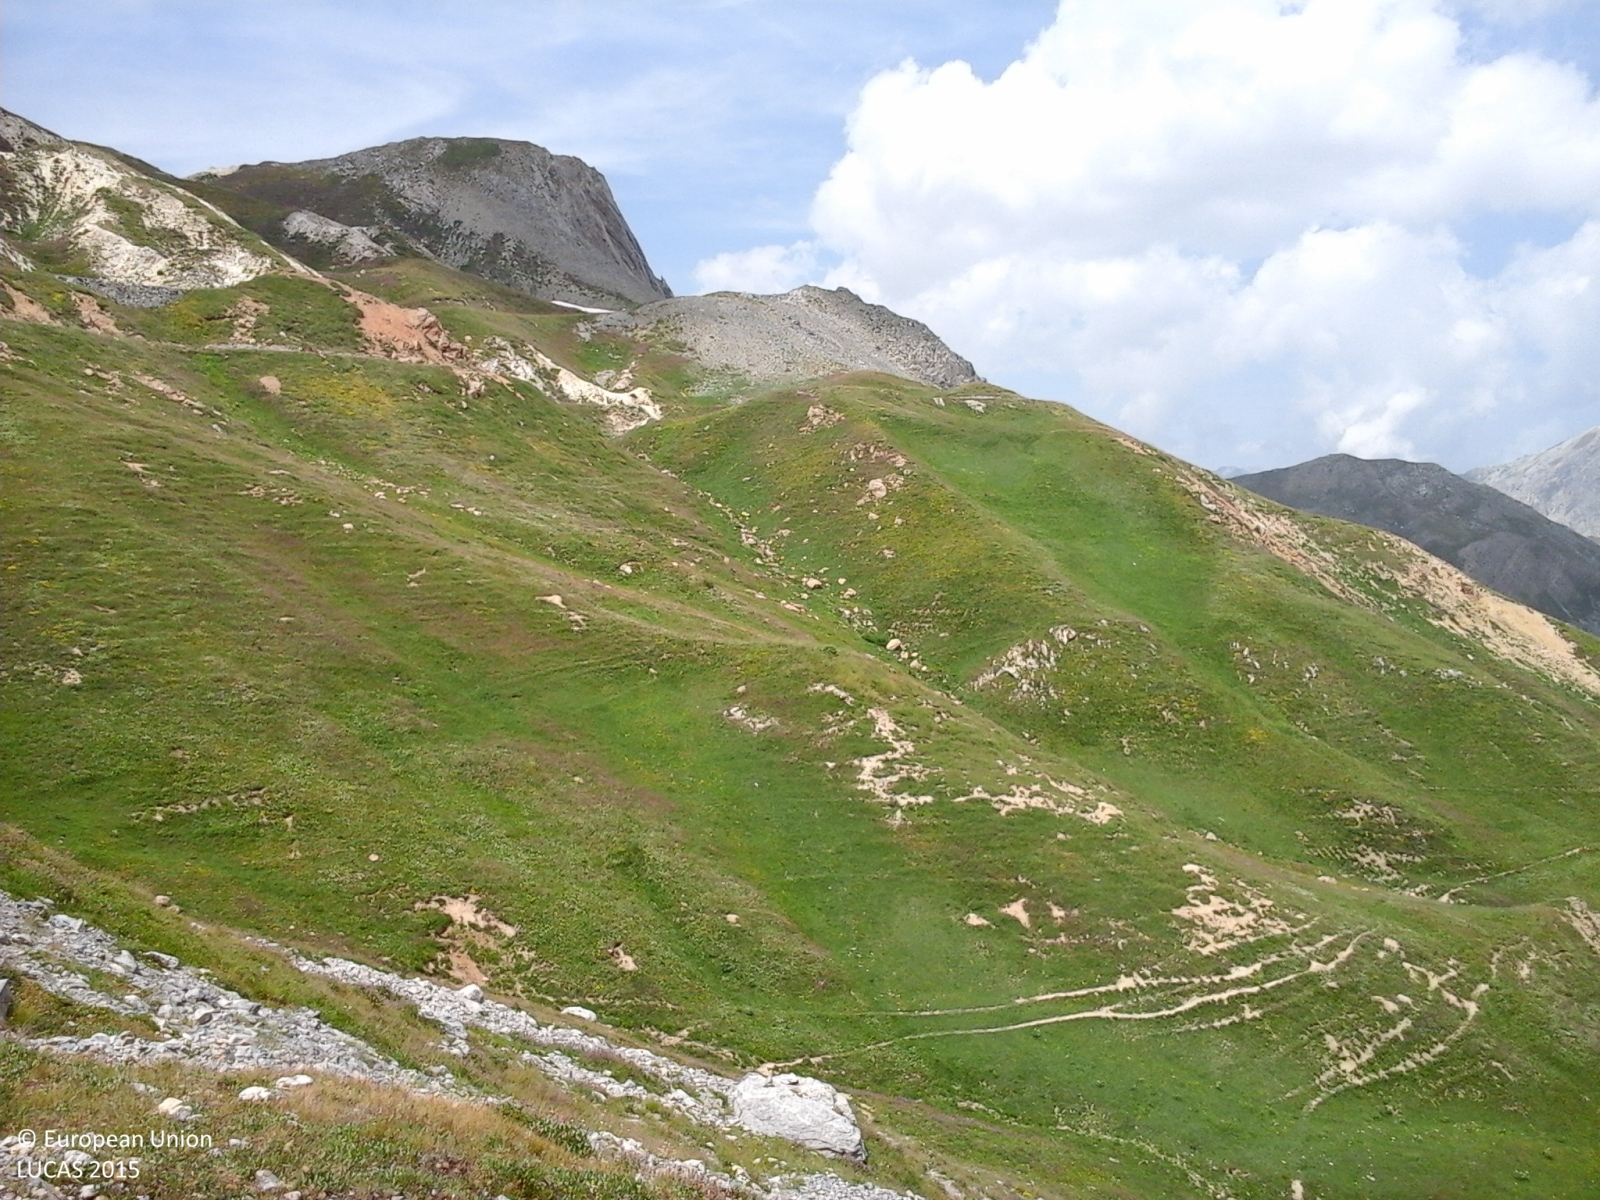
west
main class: Grassland
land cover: Grassland without tree/shrub cover
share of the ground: > 75 %
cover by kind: herbaceous plants 80 %, consolidated bare surface 20 %
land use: Agriculture (excluding fallow land and kitchen gardens)
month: July
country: IT
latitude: 44.3810
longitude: 7.0563
